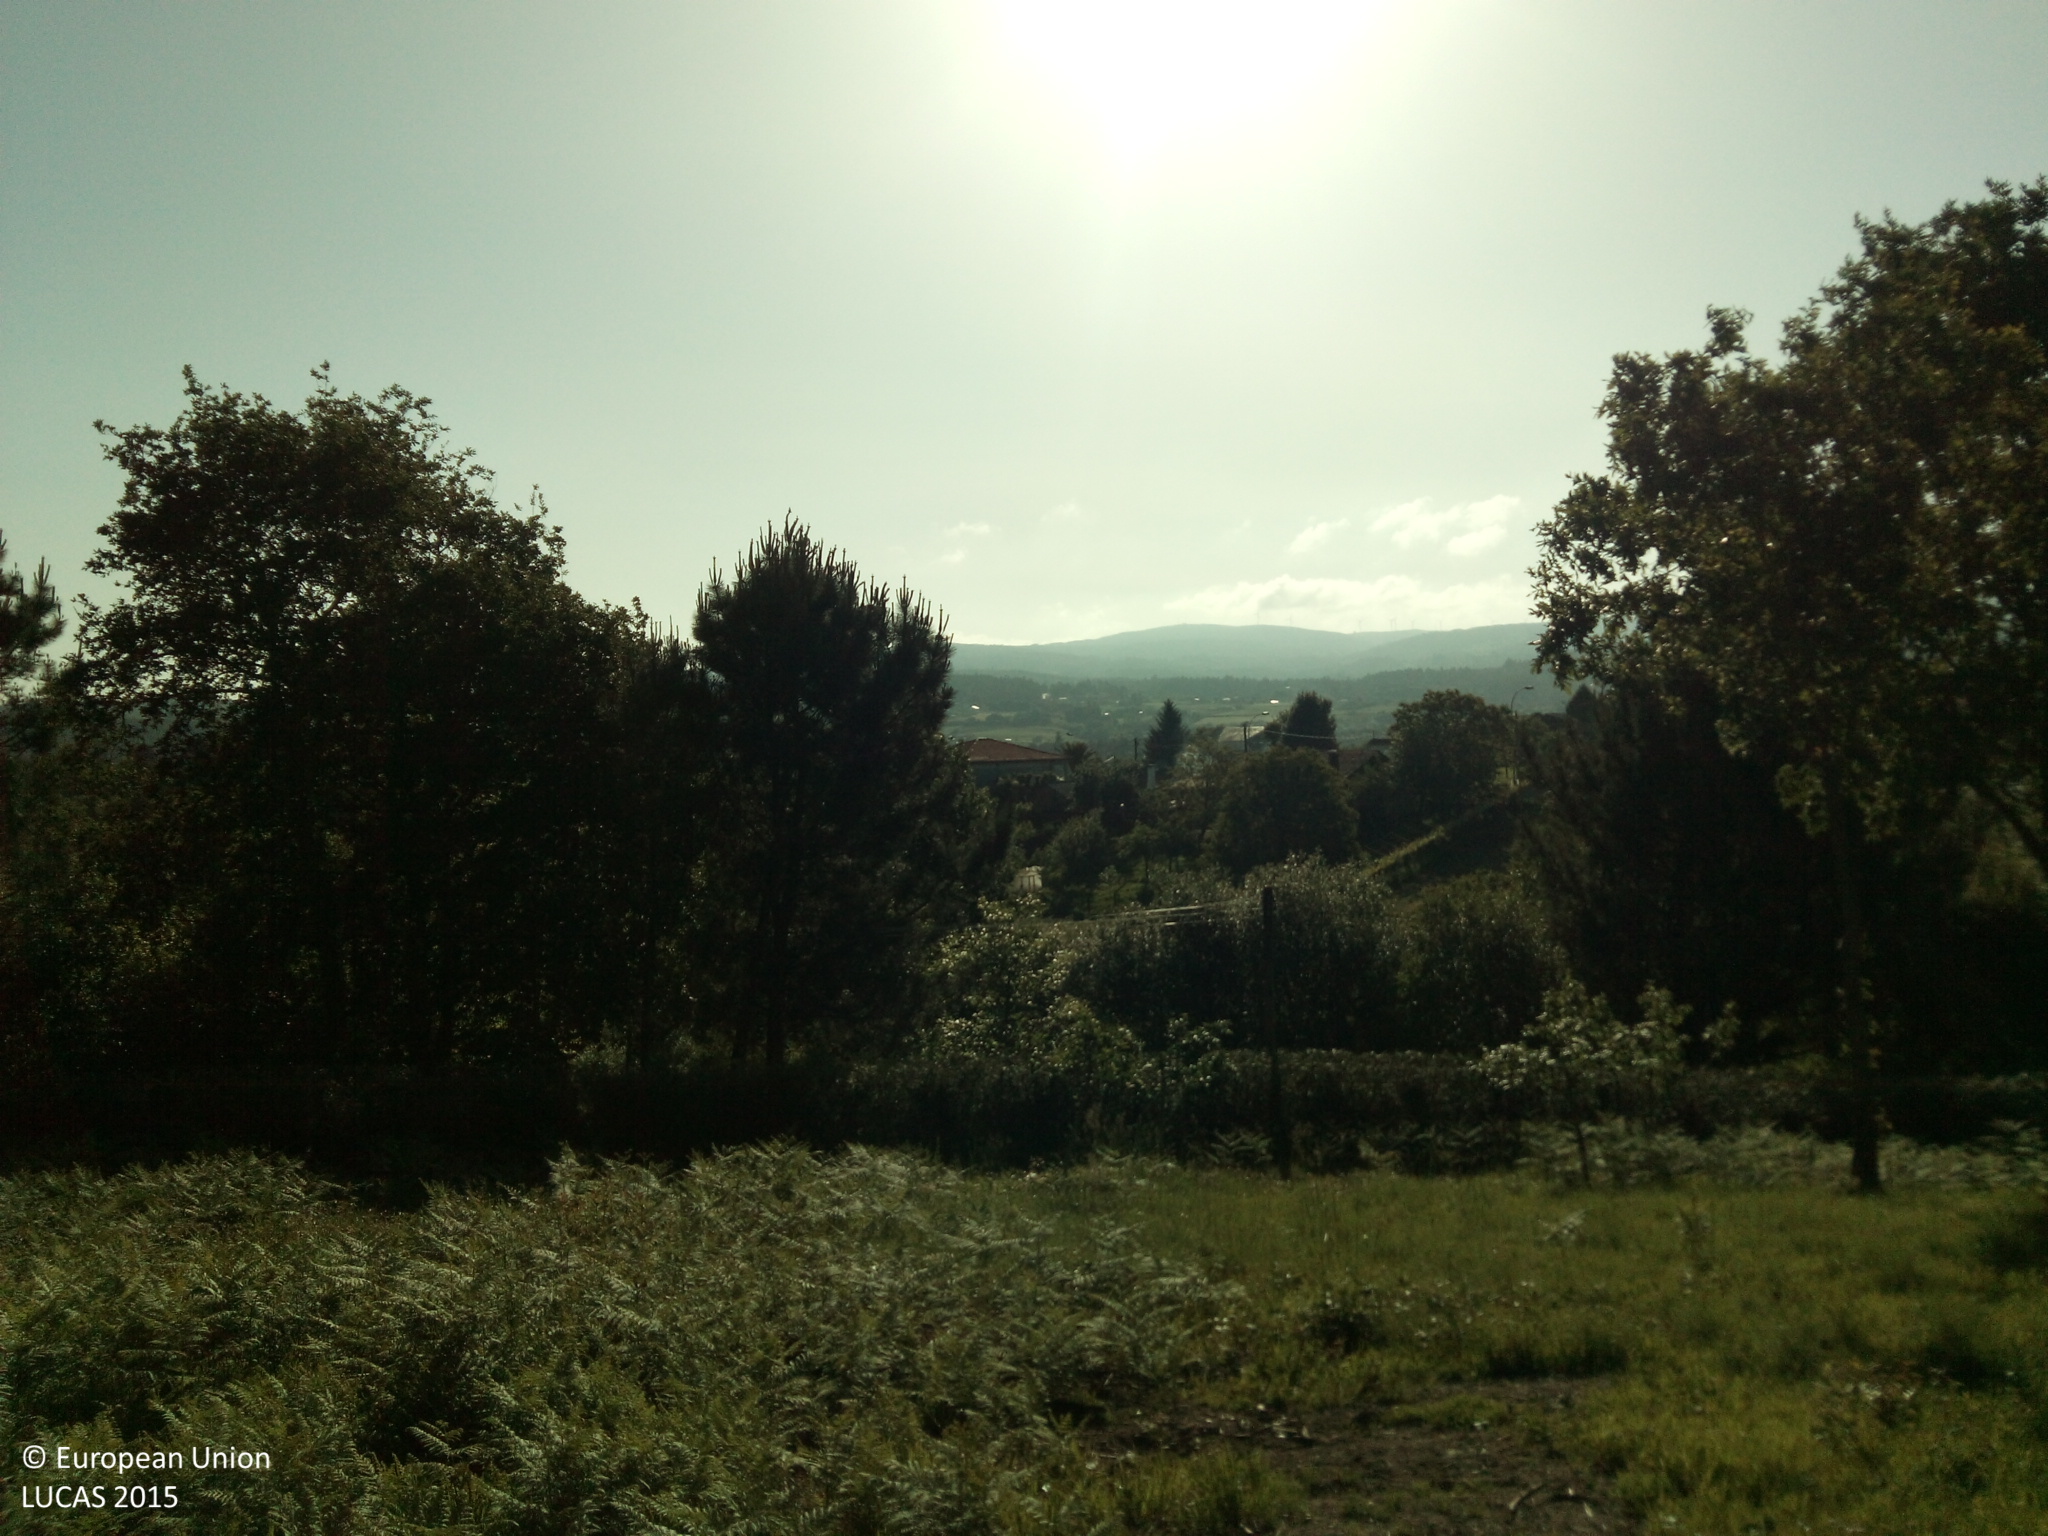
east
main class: Grassland
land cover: Grassland without tree/shrub cover
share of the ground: > 75 %
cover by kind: herbaceous plants 100 %
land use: Abandoned areas
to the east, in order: Grassland without tree/shrub cover; Conifer hedges; Electric lines; Artificial constructions; Ditches and canals; Grass margins; Paved roads, cycling and walking lanes; Grass margins; Pine dominated mixed woodland; Shrubland without tree cover; Grassland without tree/shrub cover; Electric lines; Tracks; Ditches and canals; Grass margins; Artificial constructions; Fences; Vineyards; Apple fruit; Artificial constructions in urban areas; Grassland without tree/shrub cover; Fences; Grassland with sparse tree/shrub cover; Fences; Shrubland without tree cover
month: May
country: ES
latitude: 42.6930
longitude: -8.4702
